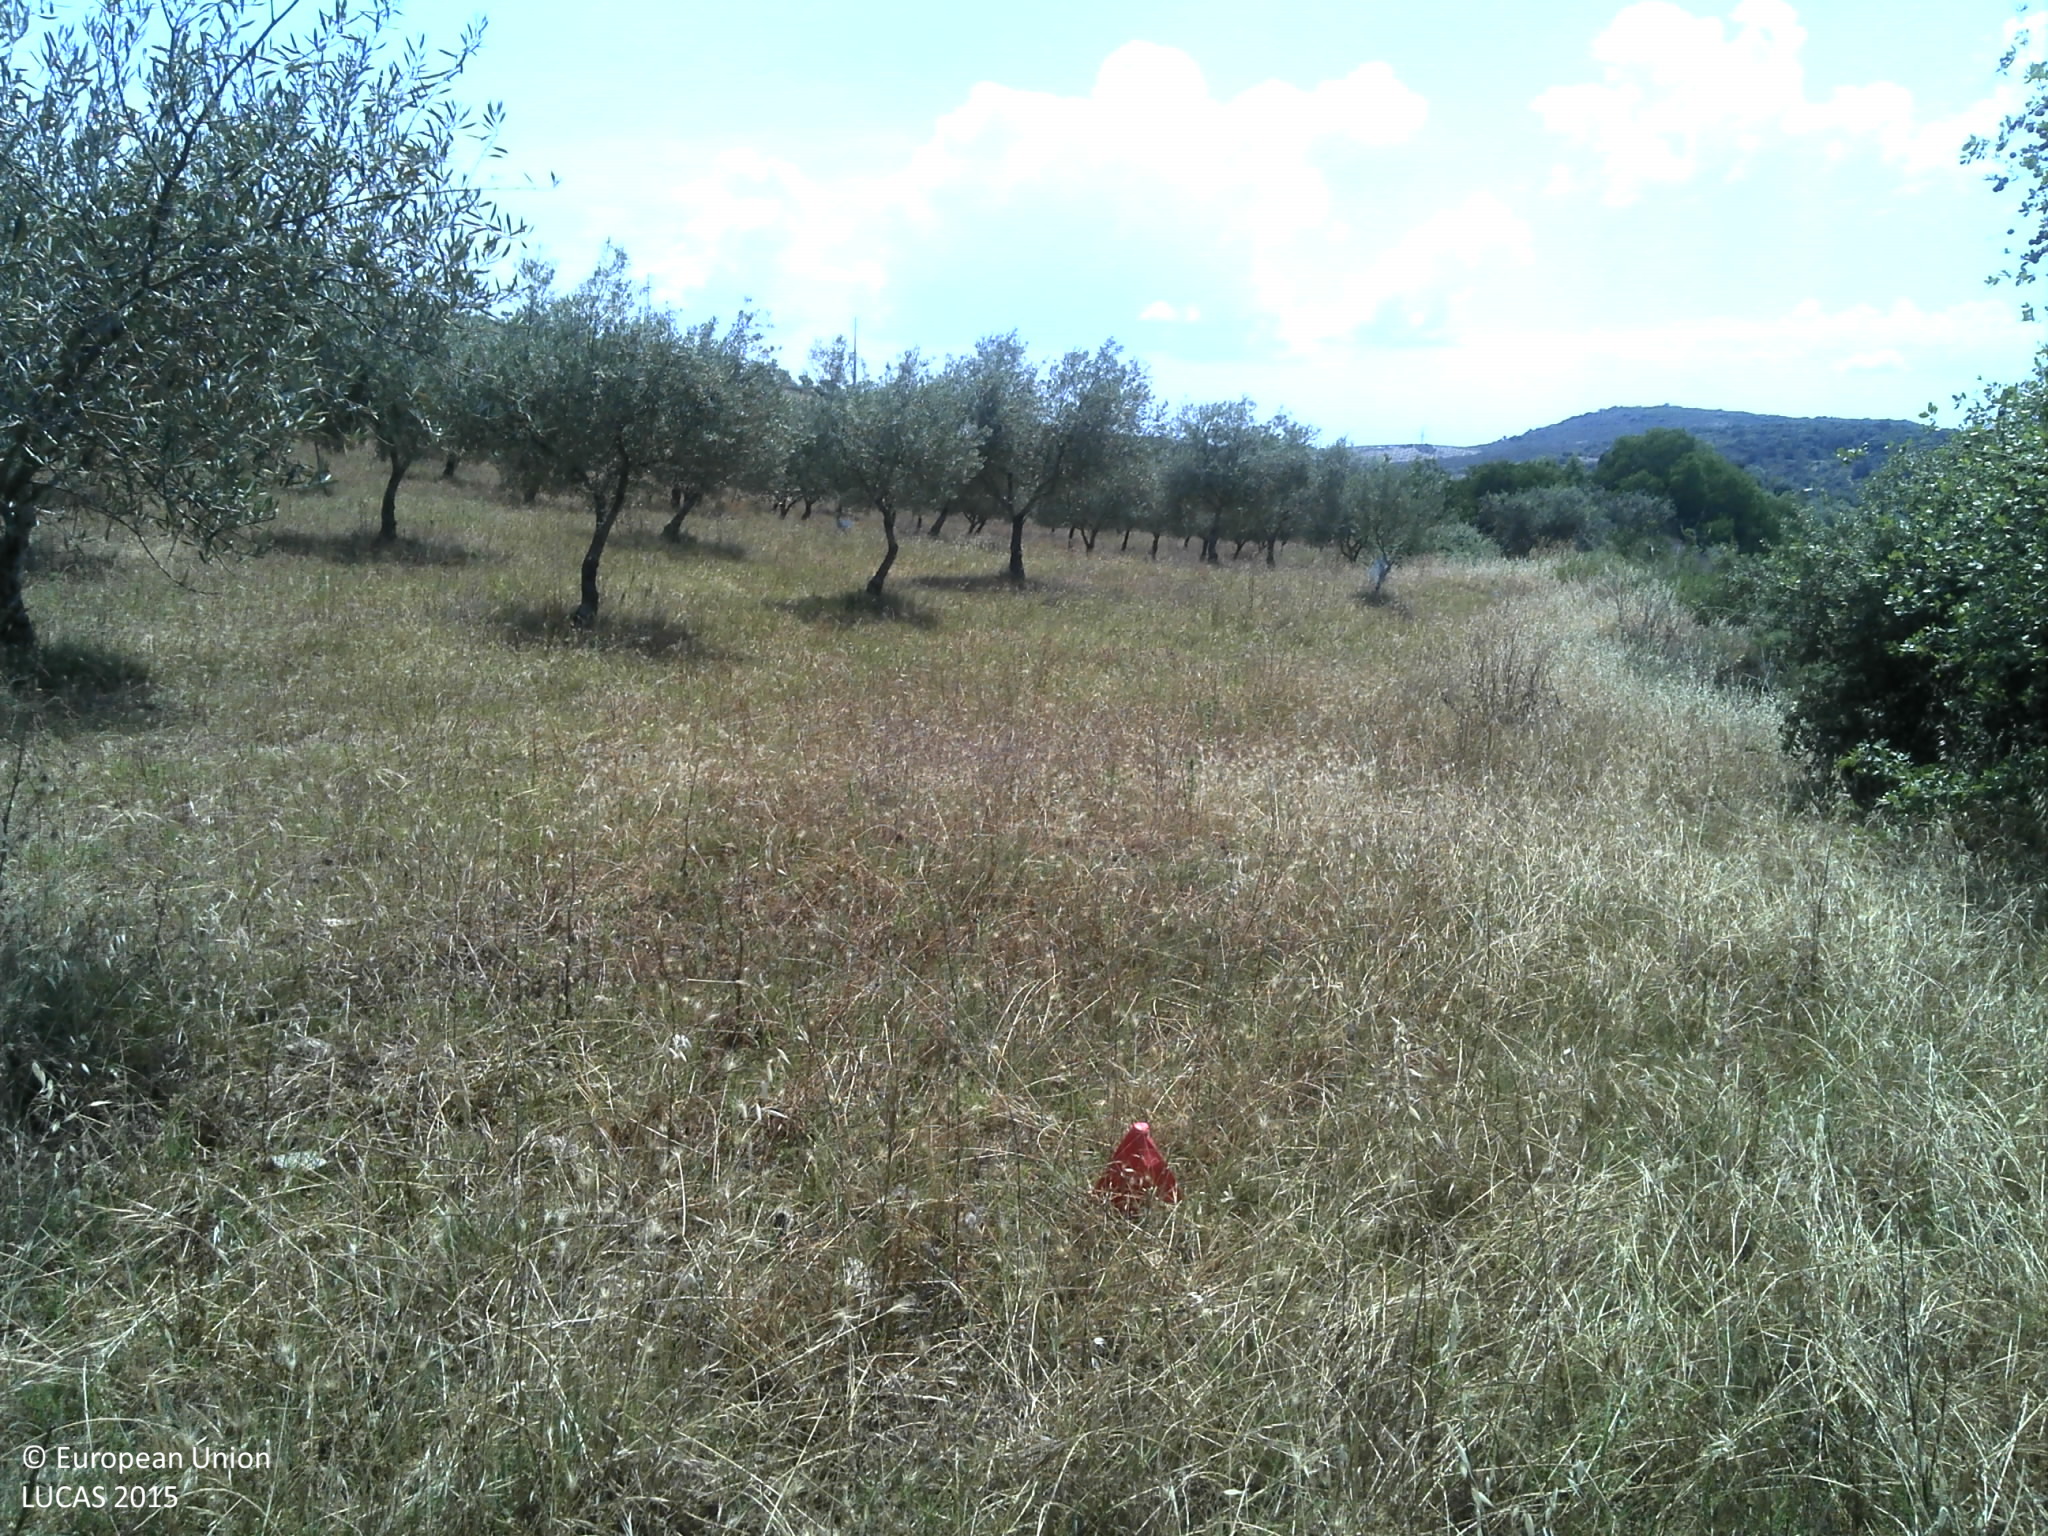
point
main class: Cropland
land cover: Olive groves
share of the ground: < 10 %
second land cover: Spontaneously vegetated surfaces
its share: 25 - 50 %
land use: Agriculture (excluding fallow land and kitchen gardens)
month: June
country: PT
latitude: 41.5151
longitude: -7.1206
